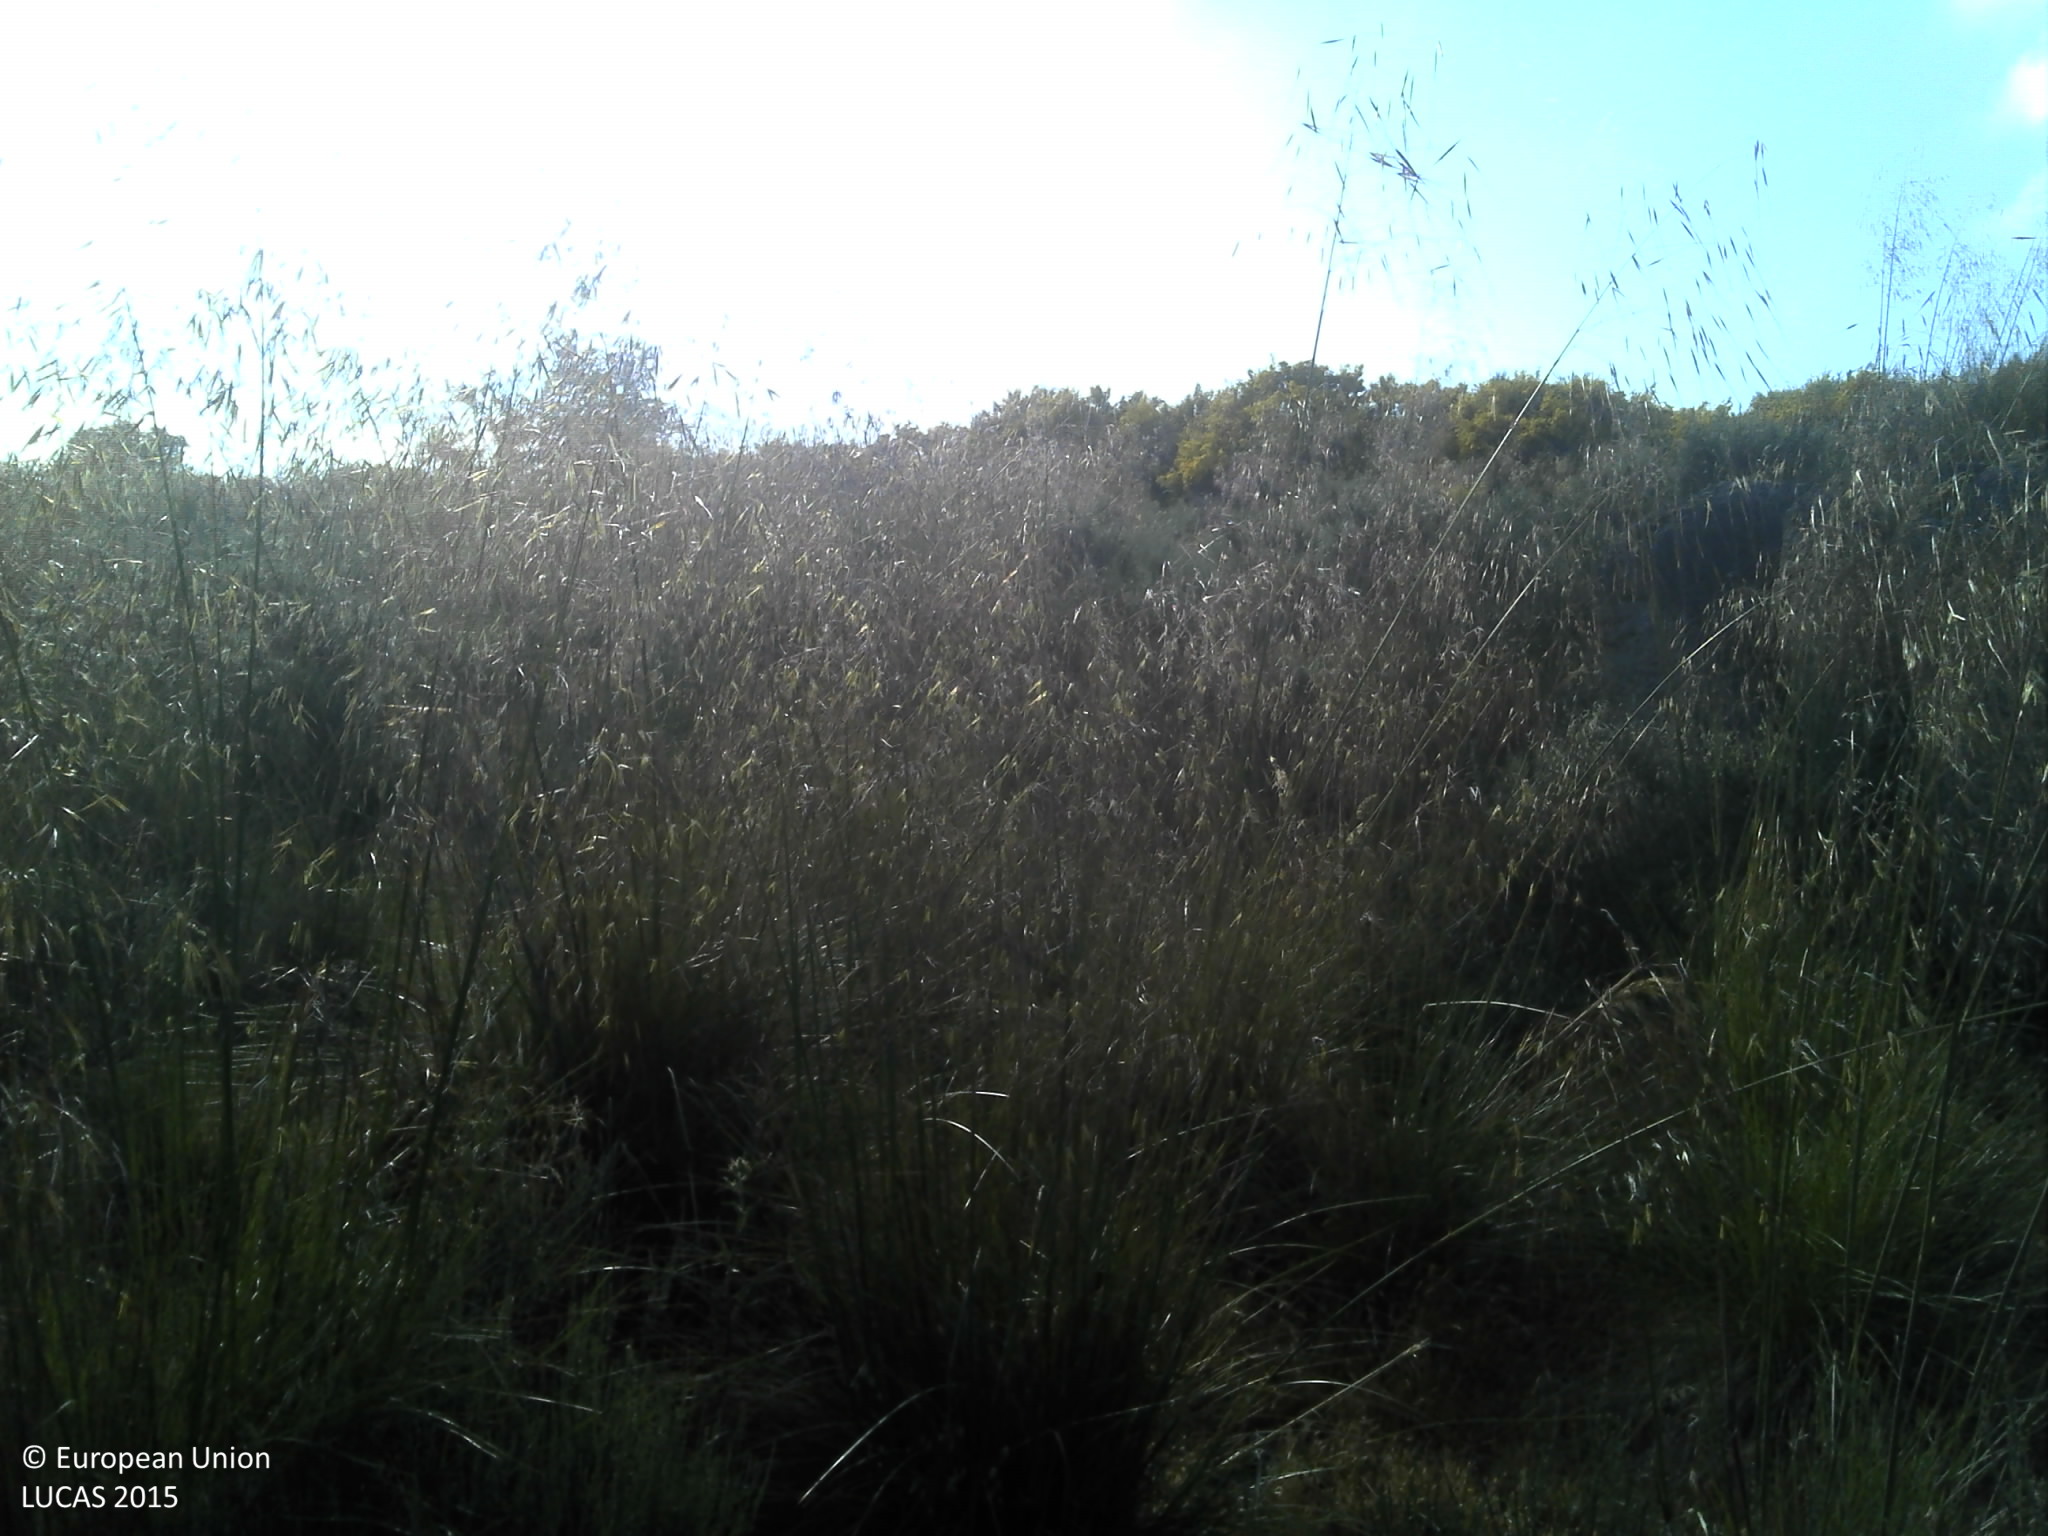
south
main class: Shrubland
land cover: Shrubland without tree cover
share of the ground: 50 - 75 %
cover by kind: shrubs 80 %, herbaceous plants 15 %
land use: Semi-natural and natural areas not in use
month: May
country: PT
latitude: 40.5852
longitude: -7.2736
